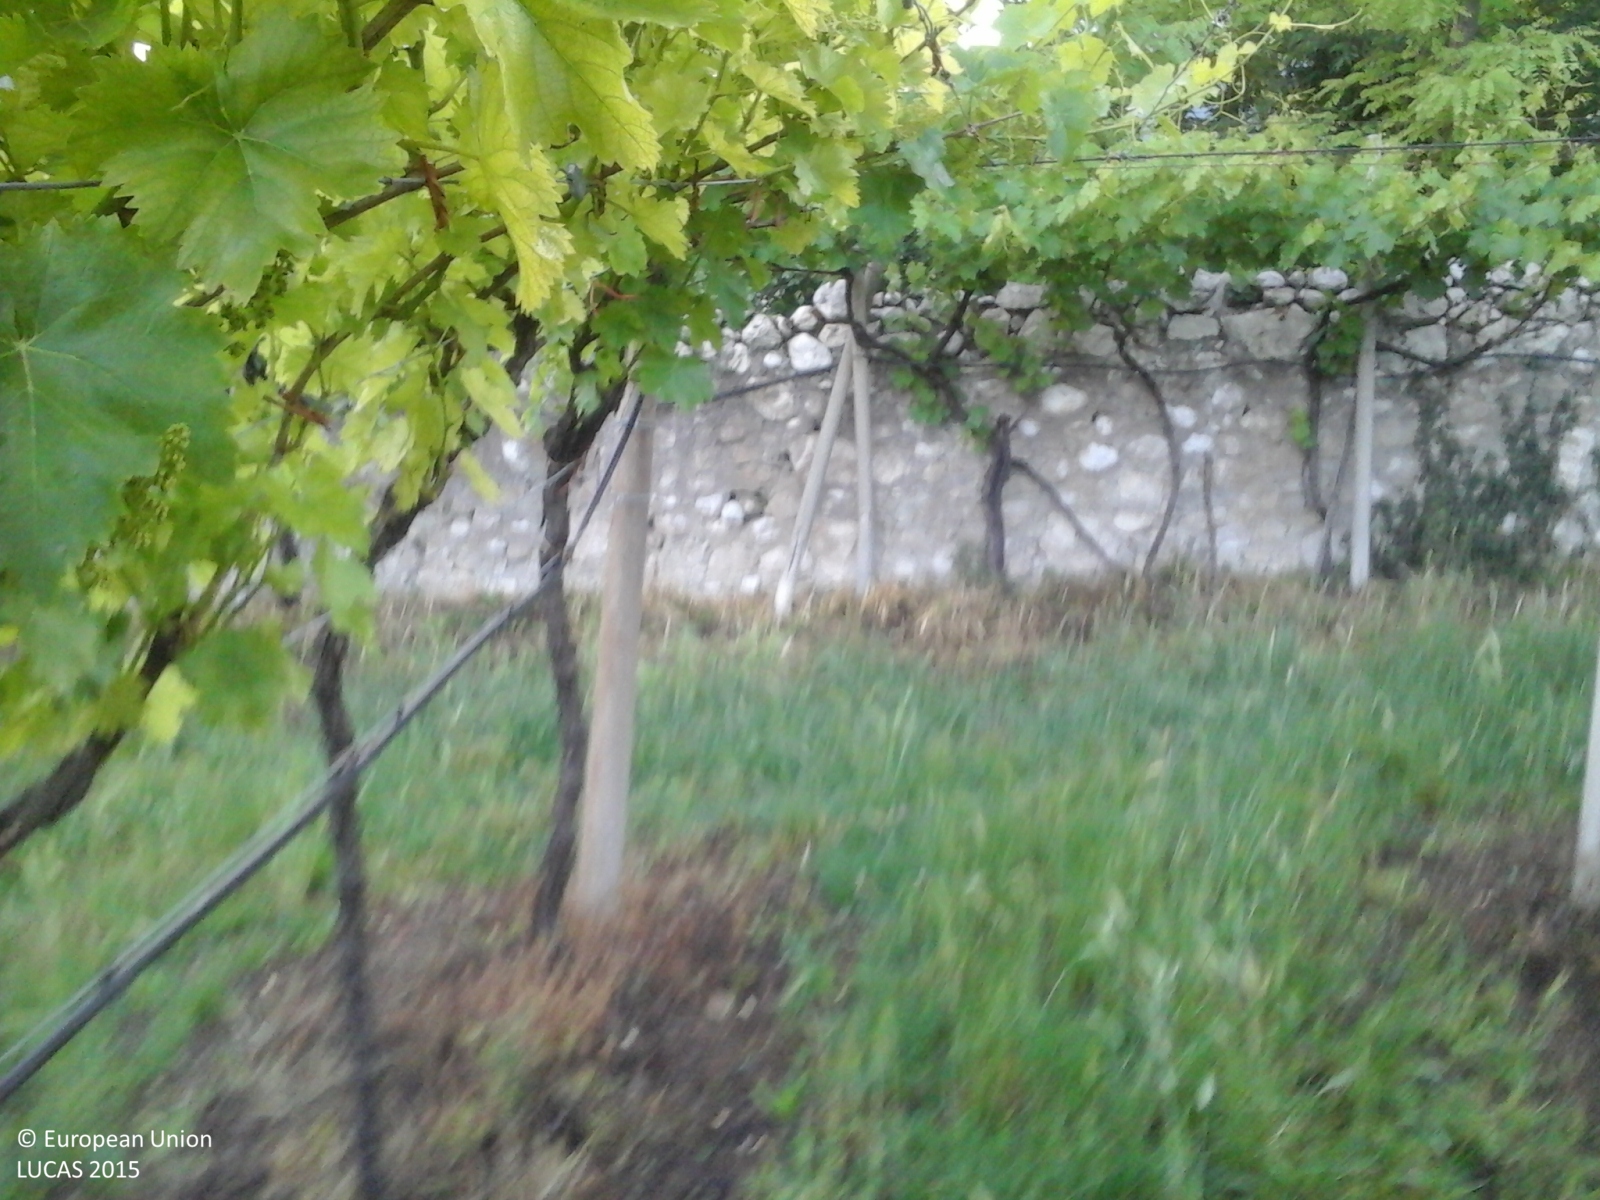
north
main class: Cropland
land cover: Vineyards
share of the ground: 10 - 25 %
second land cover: Grassland without tree/shrub cover
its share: > 75 %
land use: Agriculture (excluding fallow land and kitchen gardens)
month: May
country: IT
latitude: 45.9312
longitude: 11.0946
